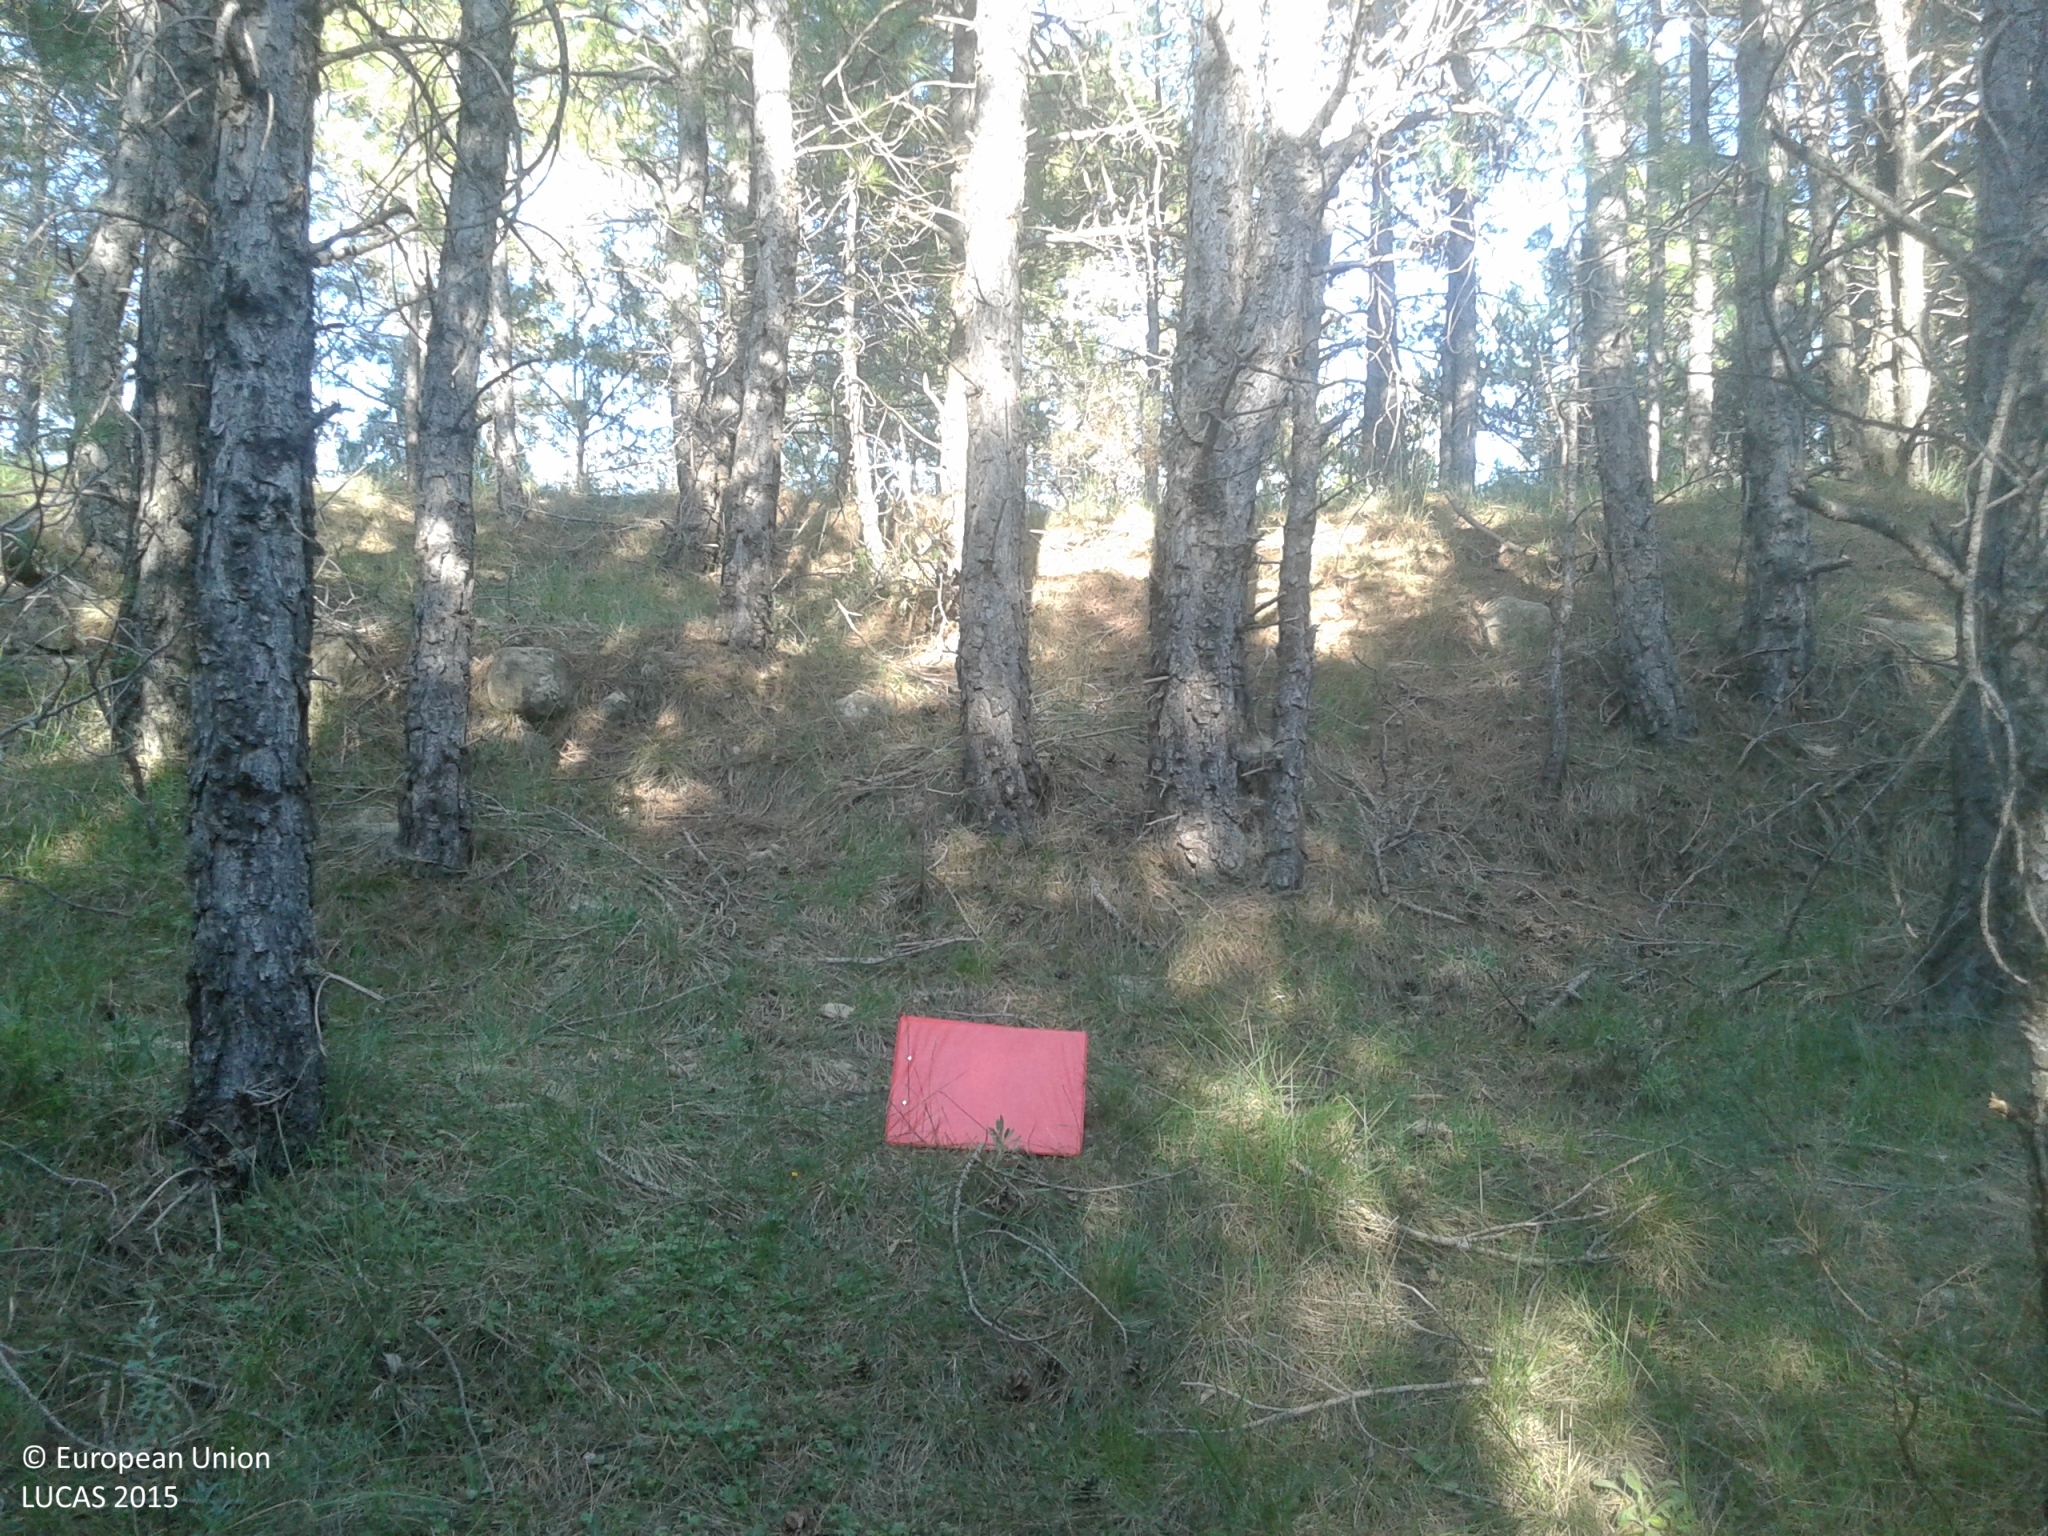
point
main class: Woodland
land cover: Pine dominated coniferous woodland
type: coniferous forest of the mediterranean region
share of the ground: > 75 %
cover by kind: coniferous forest trees 95 %, shrubs 5 %
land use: Semi-natural and natural areas not in use
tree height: > 5 m
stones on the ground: 10 - 25 %
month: May
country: ES
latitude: 42.0538
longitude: 1.6391
